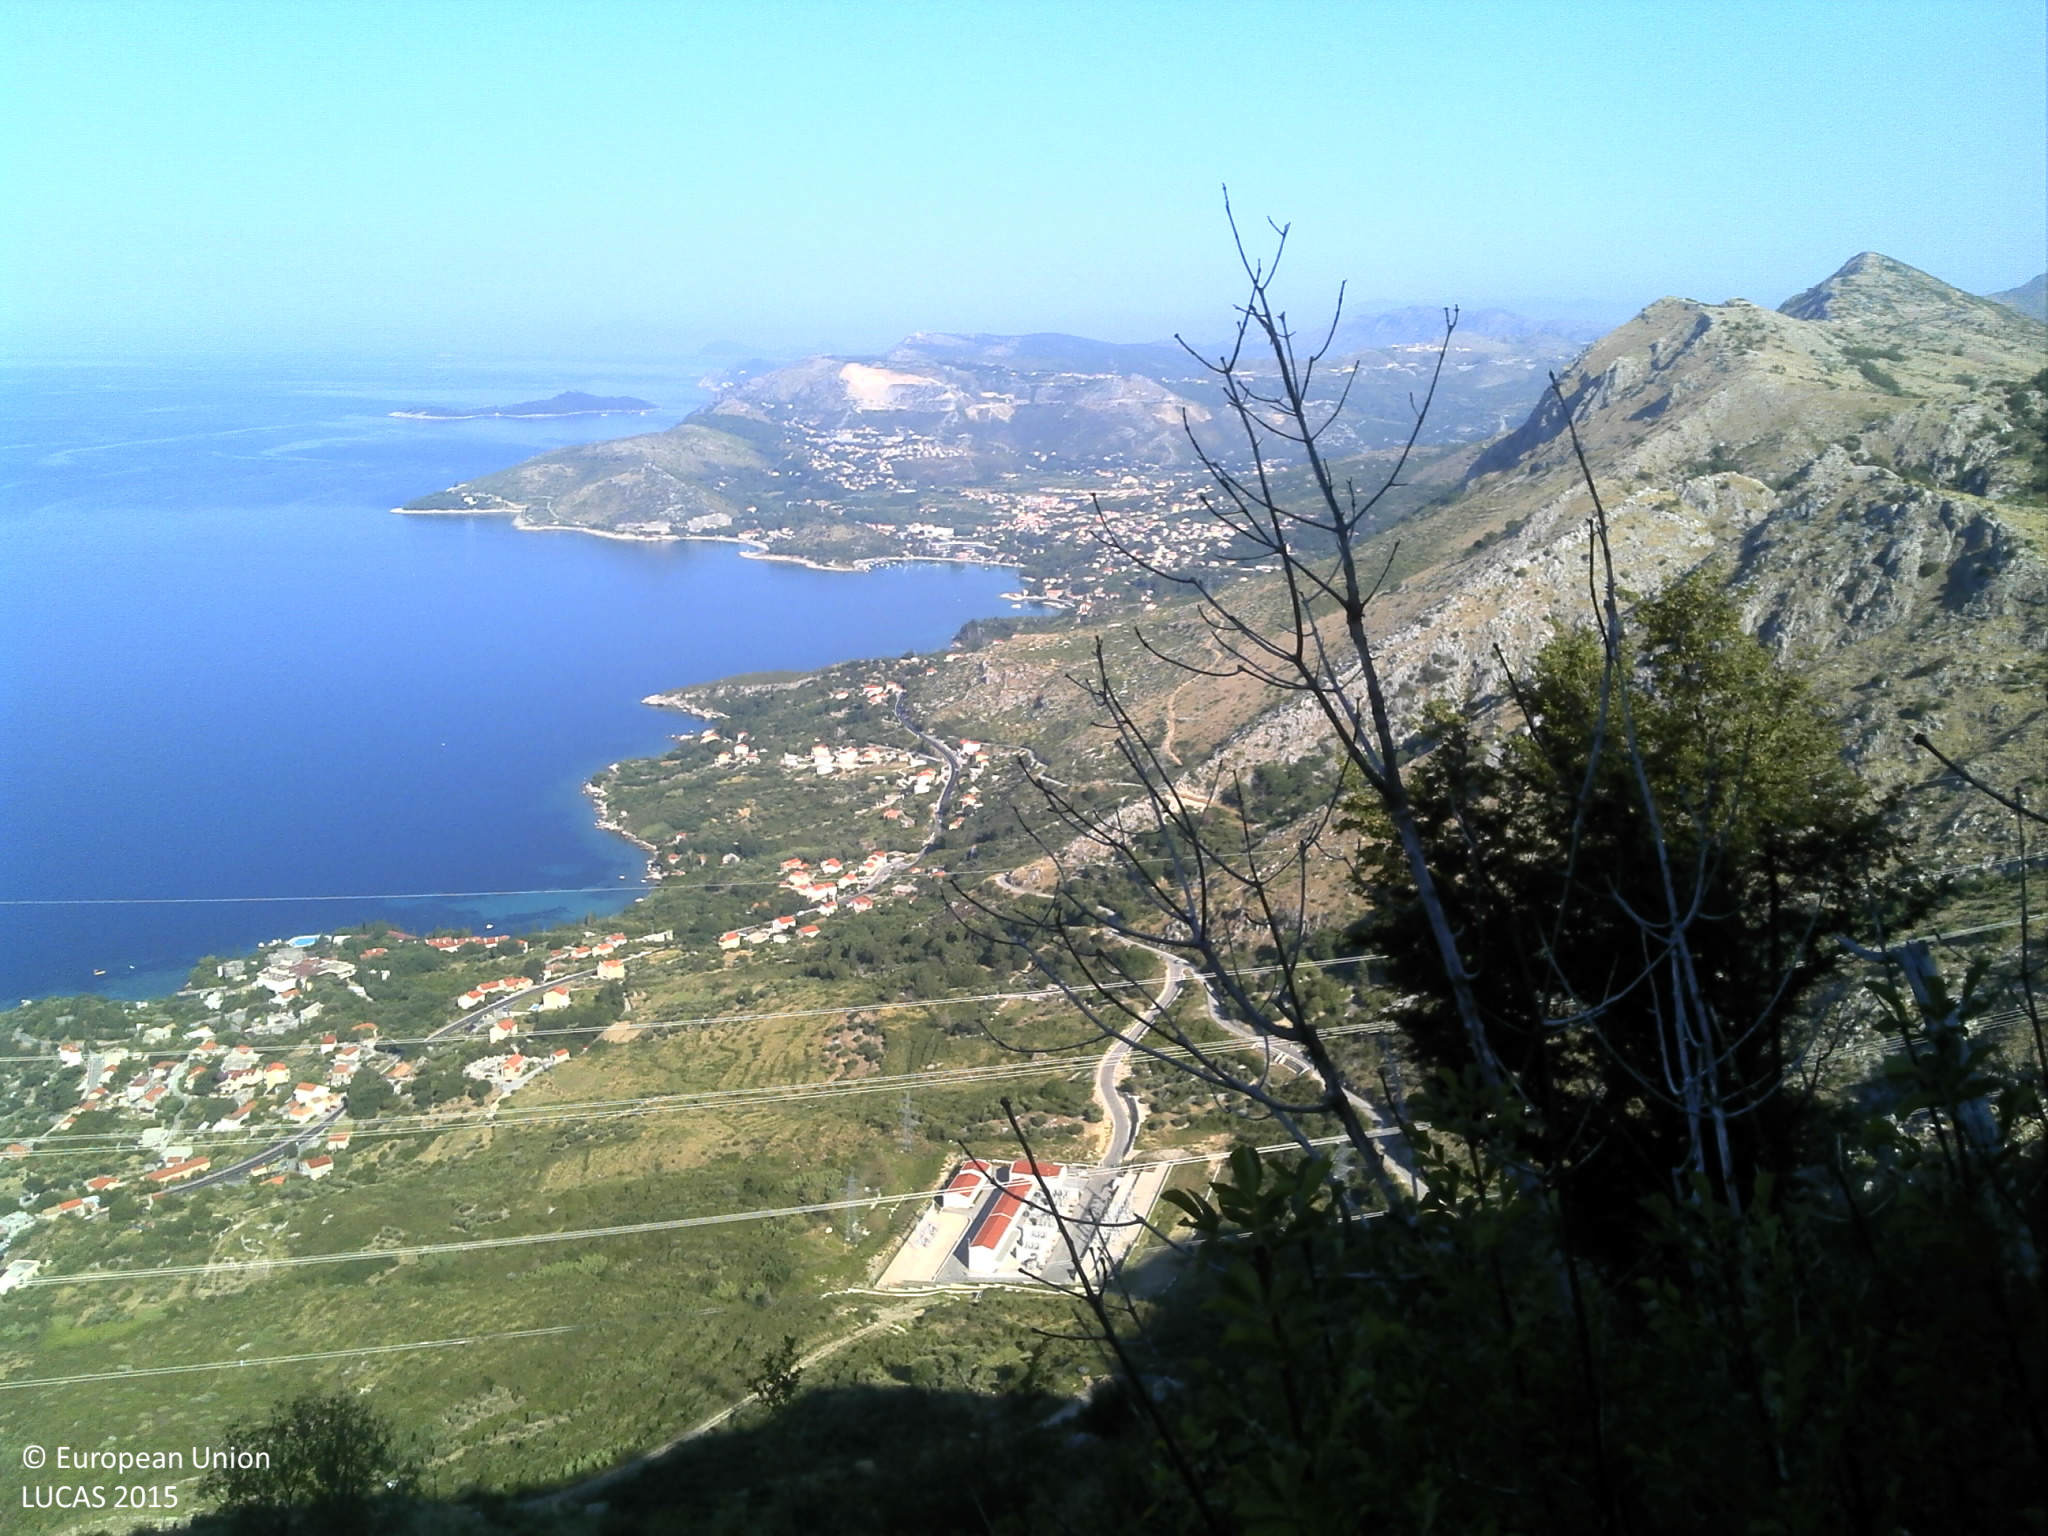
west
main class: Shrubland
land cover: Shrubland with sparse tree cover
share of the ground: 25 - 50 %
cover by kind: herbaceous plants 40 %, unconsolidated bare surface 30 %, shrubs 25 %, broadleaved forest trees 5 %
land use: Semi-natural and natural areas not in use
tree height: < 5 m
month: July
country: HR
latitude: 42.6079
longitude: 18.2428
